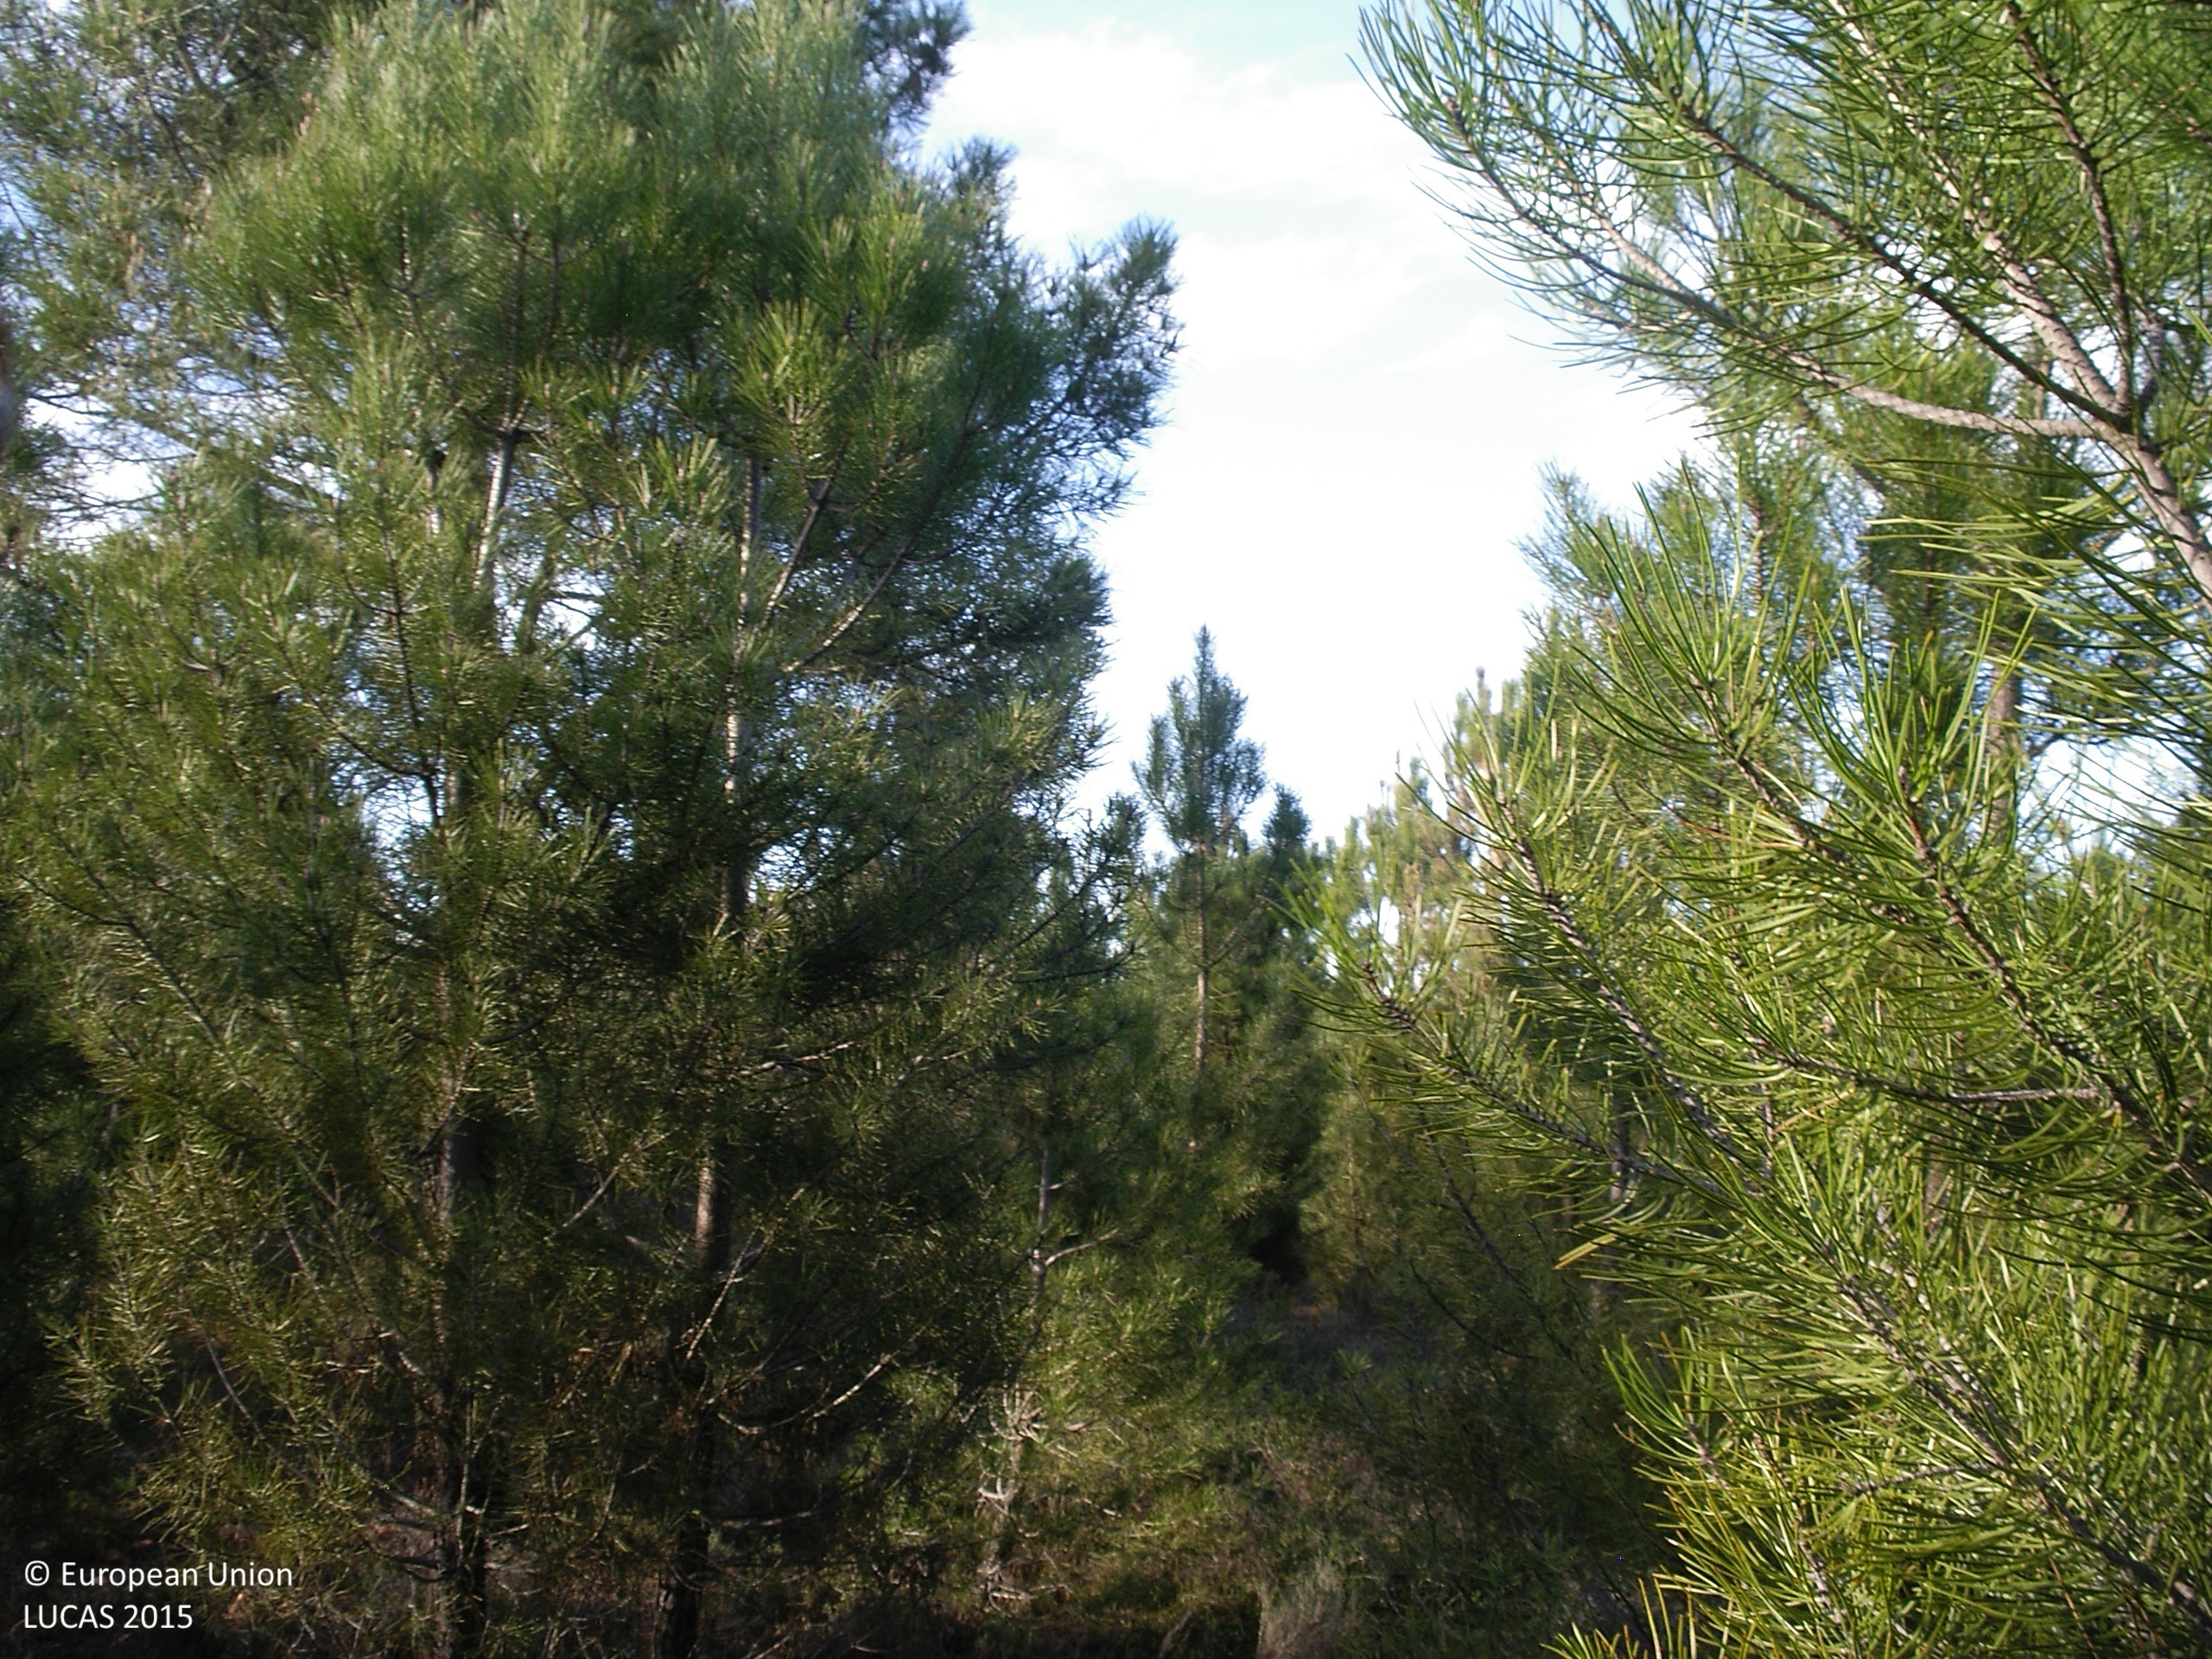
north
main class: Woodland
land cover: Pine dominated coniferous woodland
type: coniferous forest of the mediterranean region
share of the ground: > 75 %
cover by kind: coniferous forest trees 90 %, shrubs 10 %
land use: Forestry
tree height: > 5 m
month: March
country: ES
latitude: 42.2969
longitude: -6.0786
